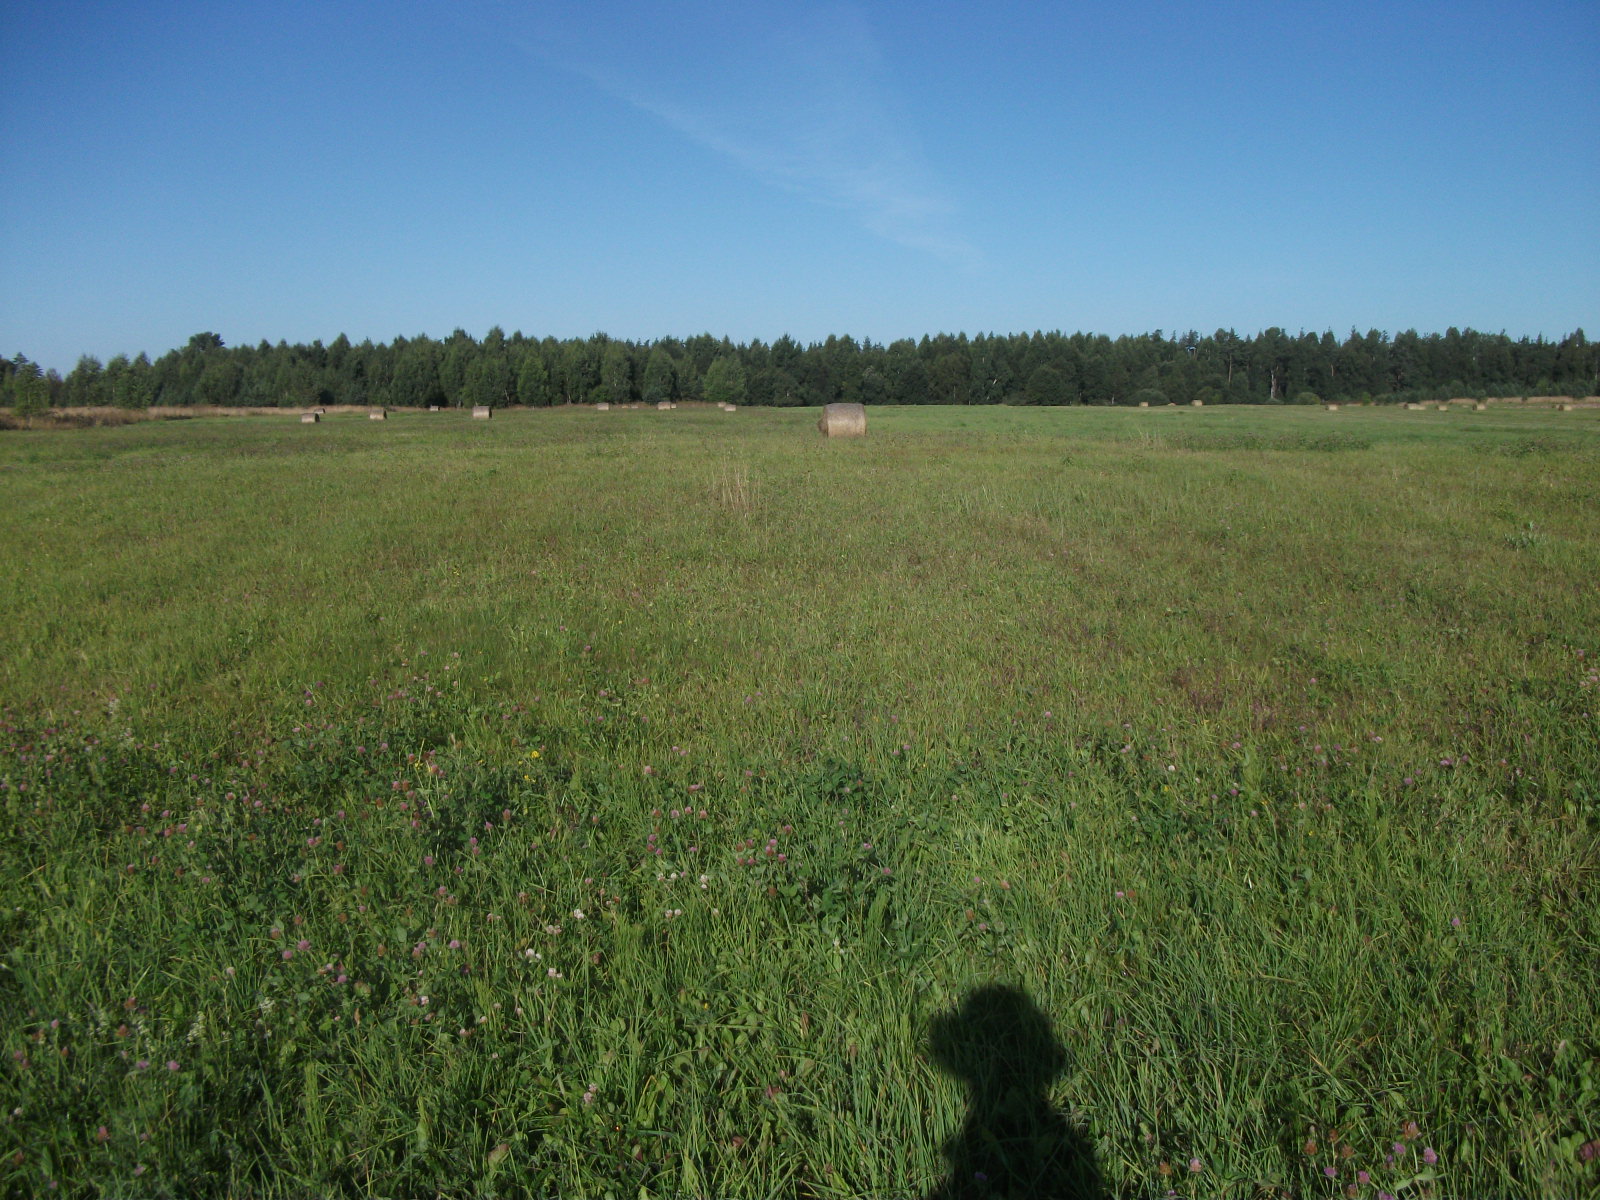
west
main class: Grassland
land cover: Grassland without tree/shrub cover
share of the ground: > 75 %
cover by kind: herbaceous plants 100 %
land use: Agriculture (excluding fallow land and kitchen gardens)
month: August
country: LV
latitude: 56.3170
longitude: 26.2607
